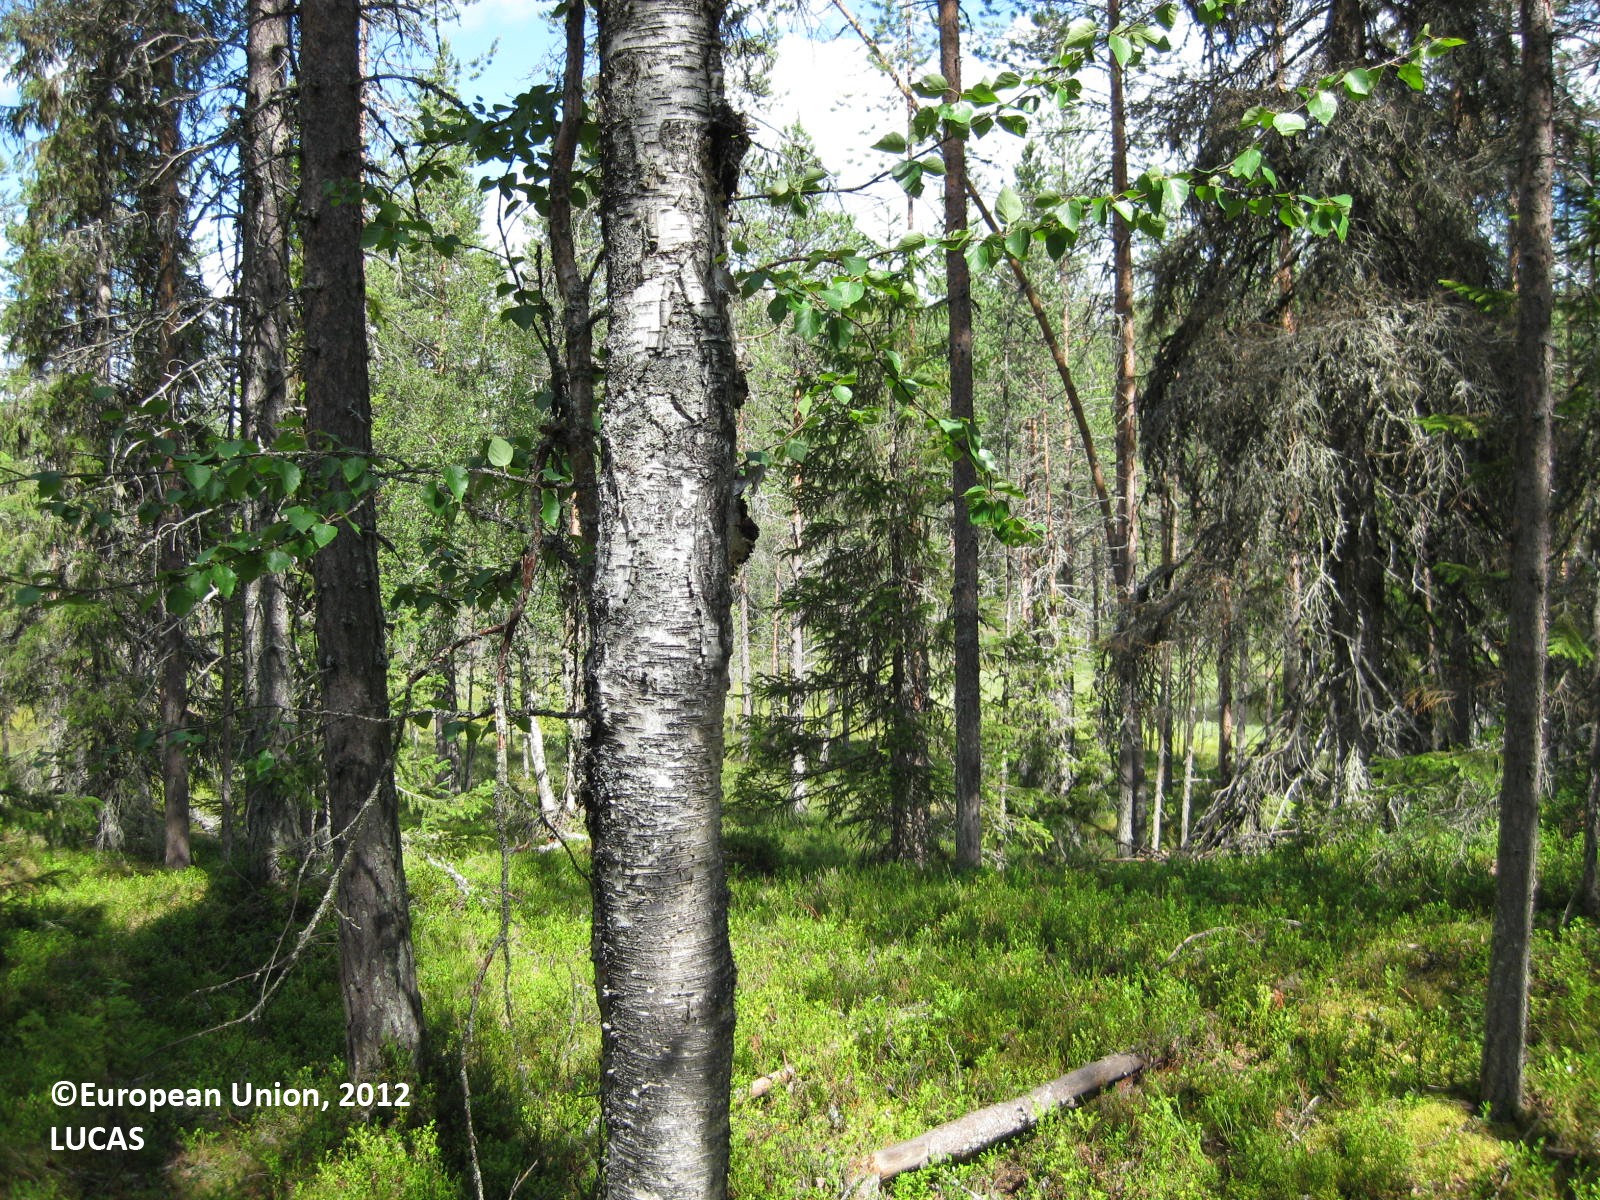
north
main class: Woodland
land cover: Pine dominated coniferous woodland
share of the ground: 50 - 75 %
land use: Forestry
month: July
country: FI
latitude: 65.7158
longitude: 28.0783
